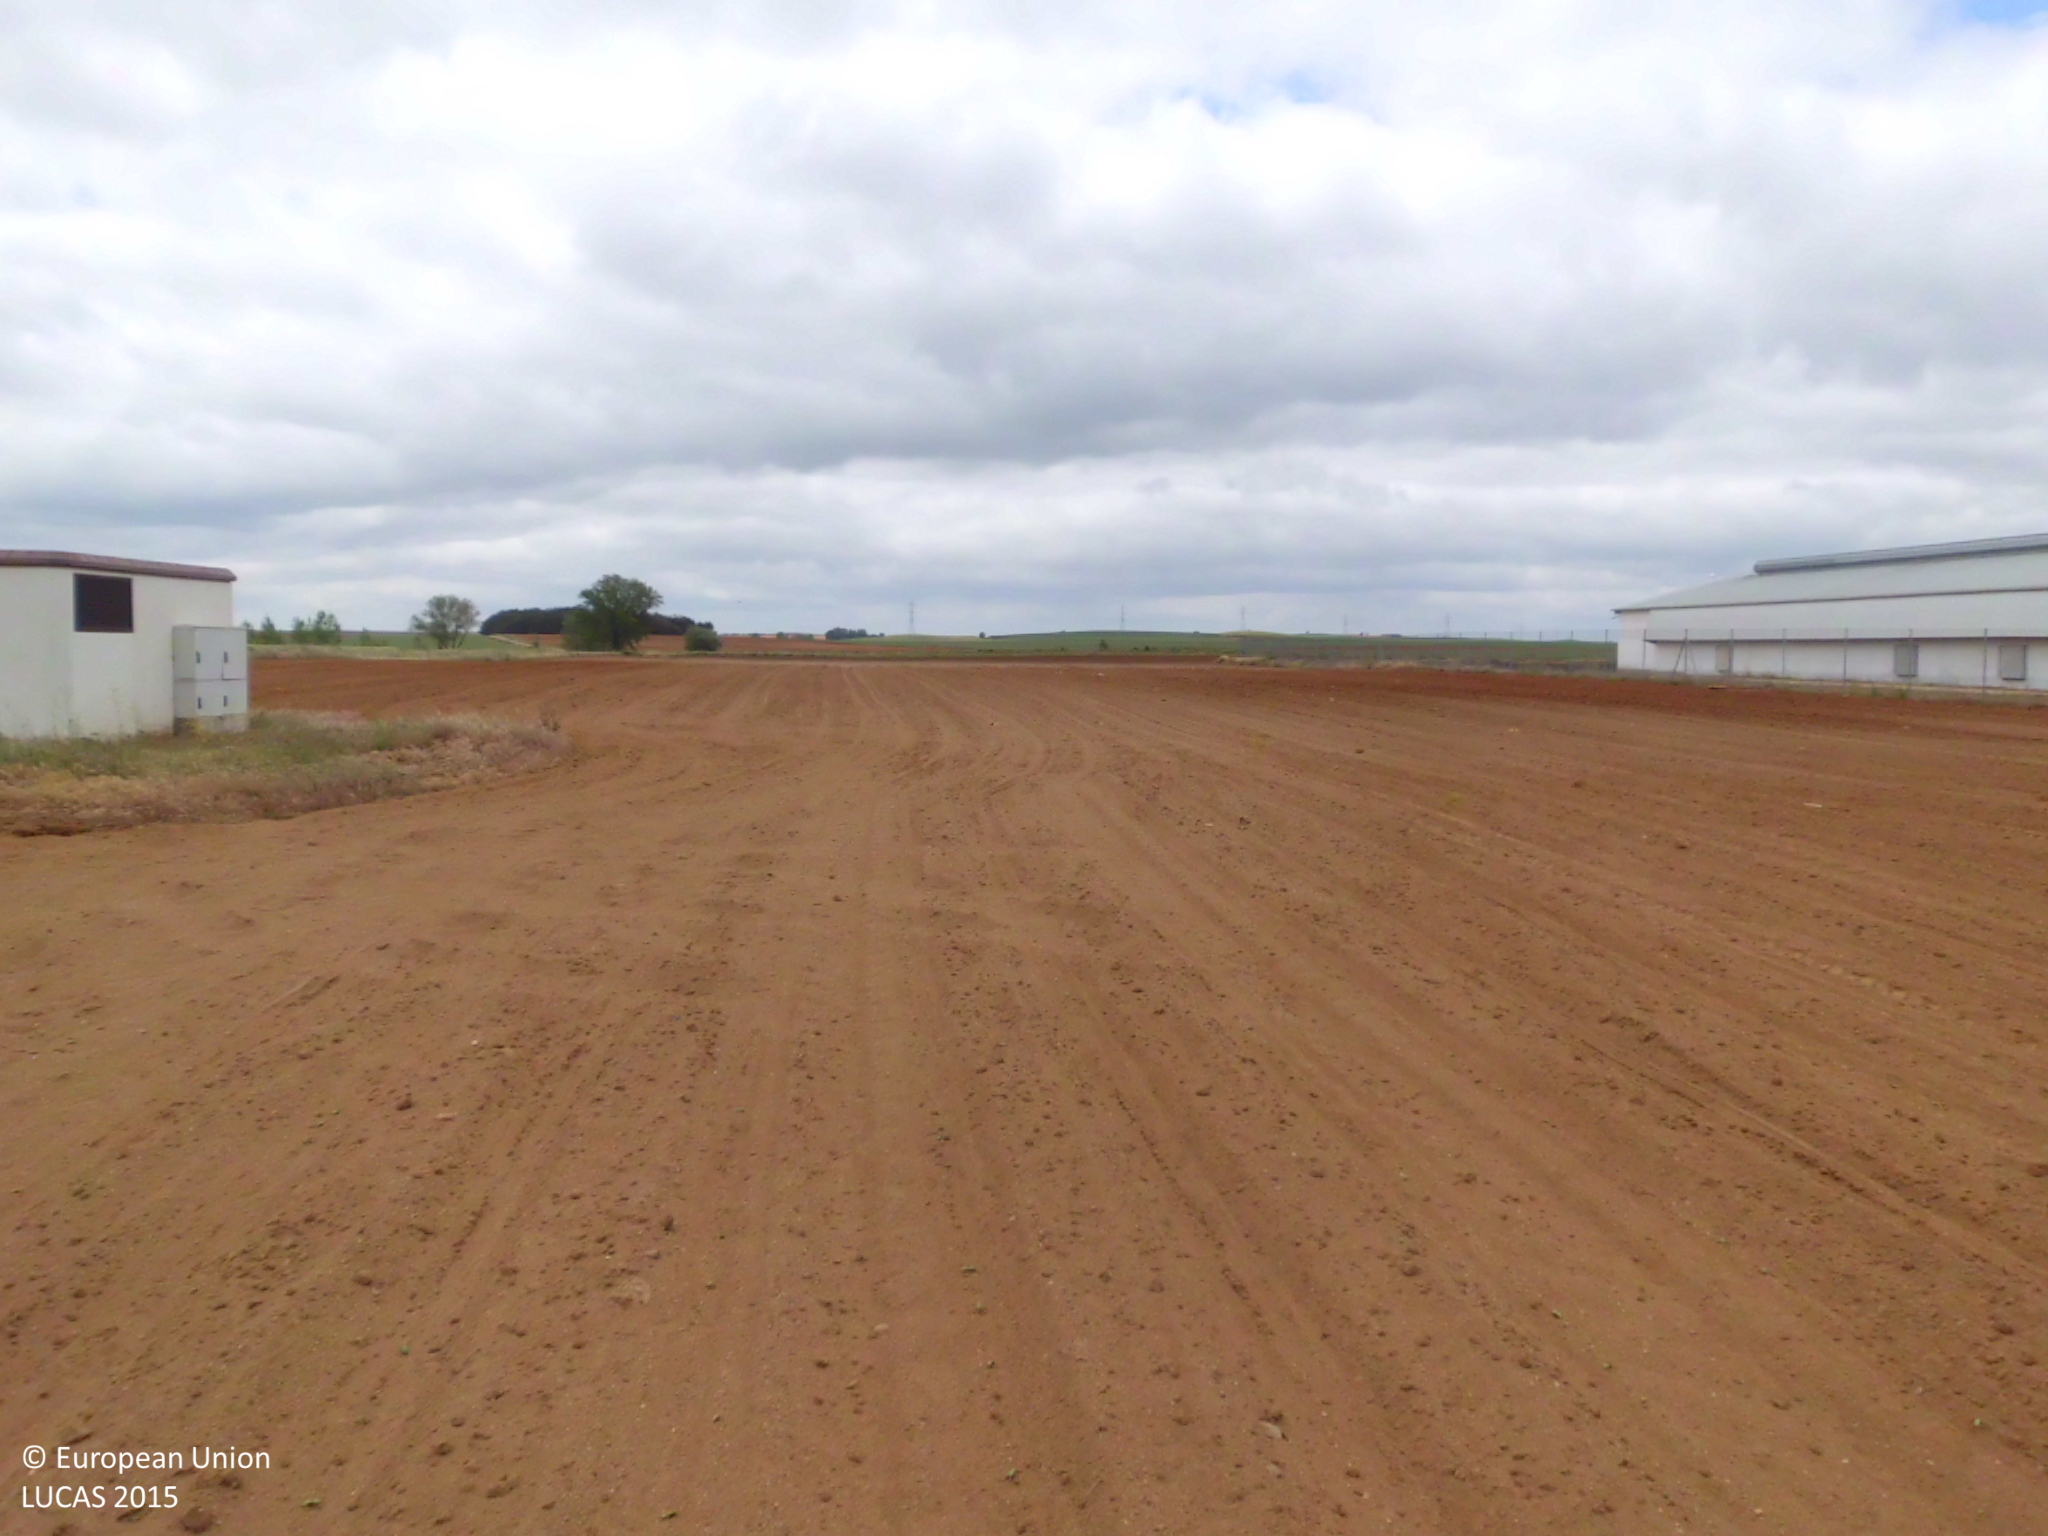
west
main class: Cropland
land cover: Sunflower
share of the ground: < 10 %
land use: Agriculture (excluding fallow land and kitchen gardens)
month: May
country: ES
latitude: 42.5141
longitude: -4.0280
